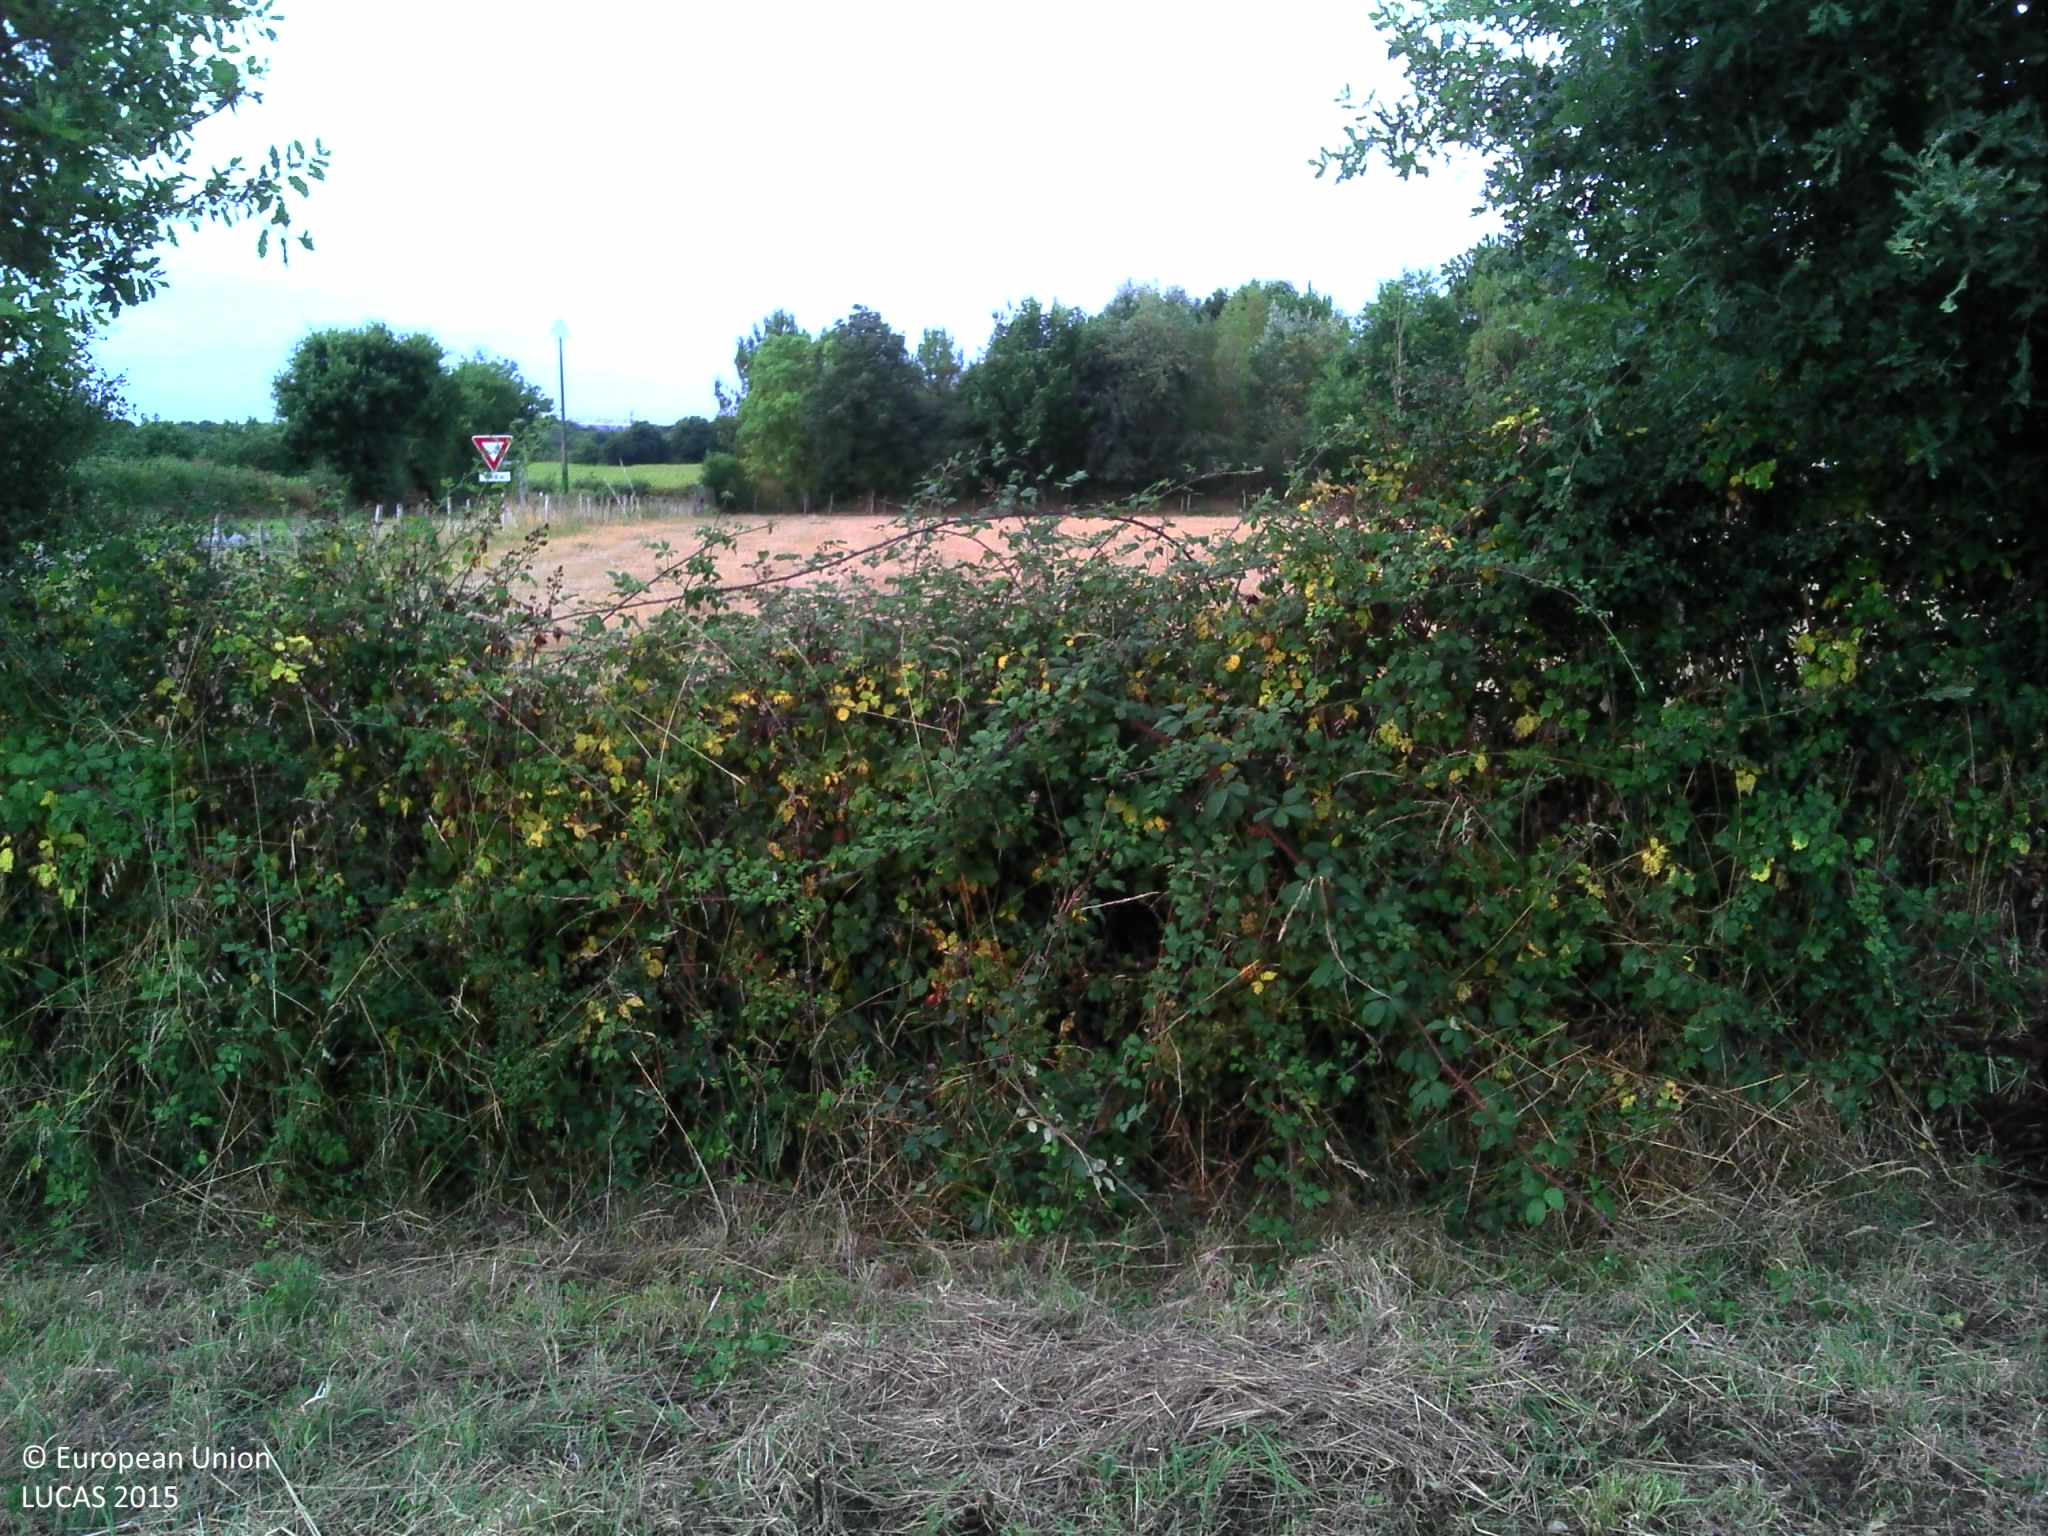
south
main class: Cropland
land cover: Temporary grasslands
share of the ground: > 75 %
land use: Agriculture (excluding fallow land and kitchen gardens)
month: August
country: FR
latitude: 47.4458
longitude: -1.5946
